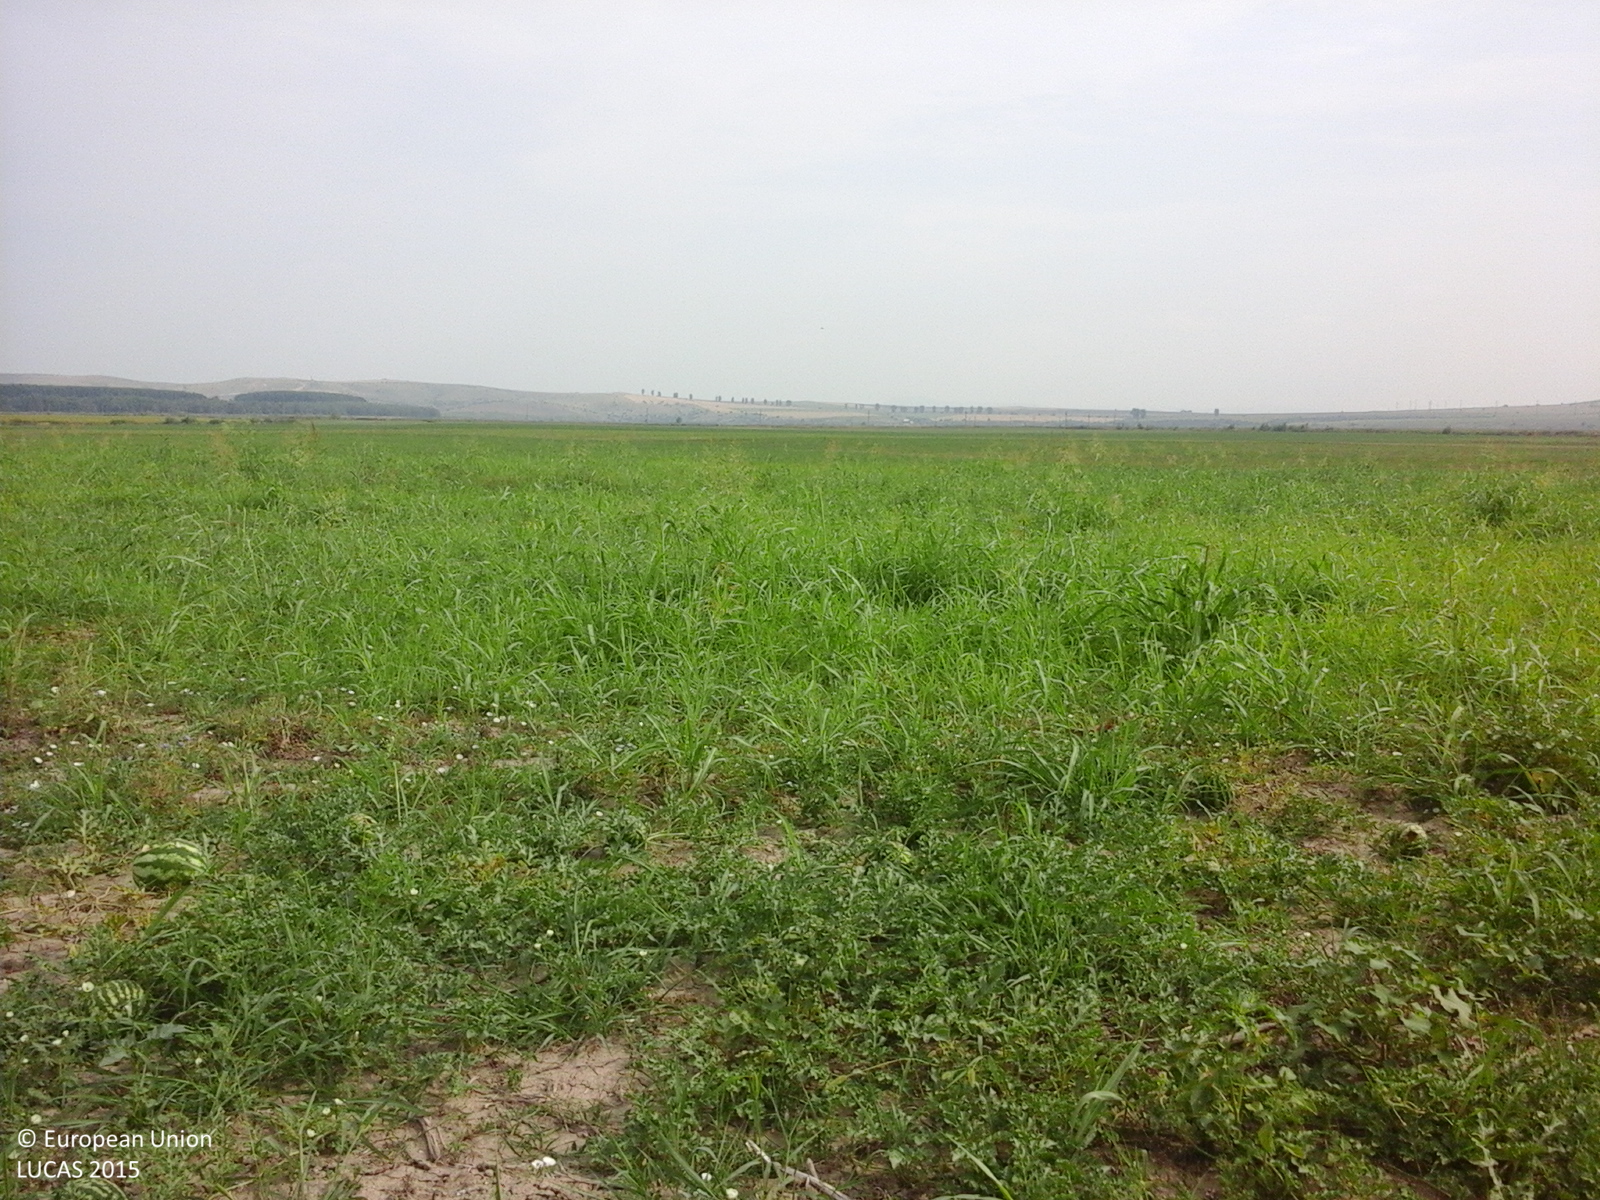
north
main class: Cropland
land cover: Other fresh vegetables
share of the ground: > 75 %
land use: Agriculture (excluding fallow land and kitchen gardens)
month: July
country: RO
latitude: 44.9470
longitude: 28.1524
